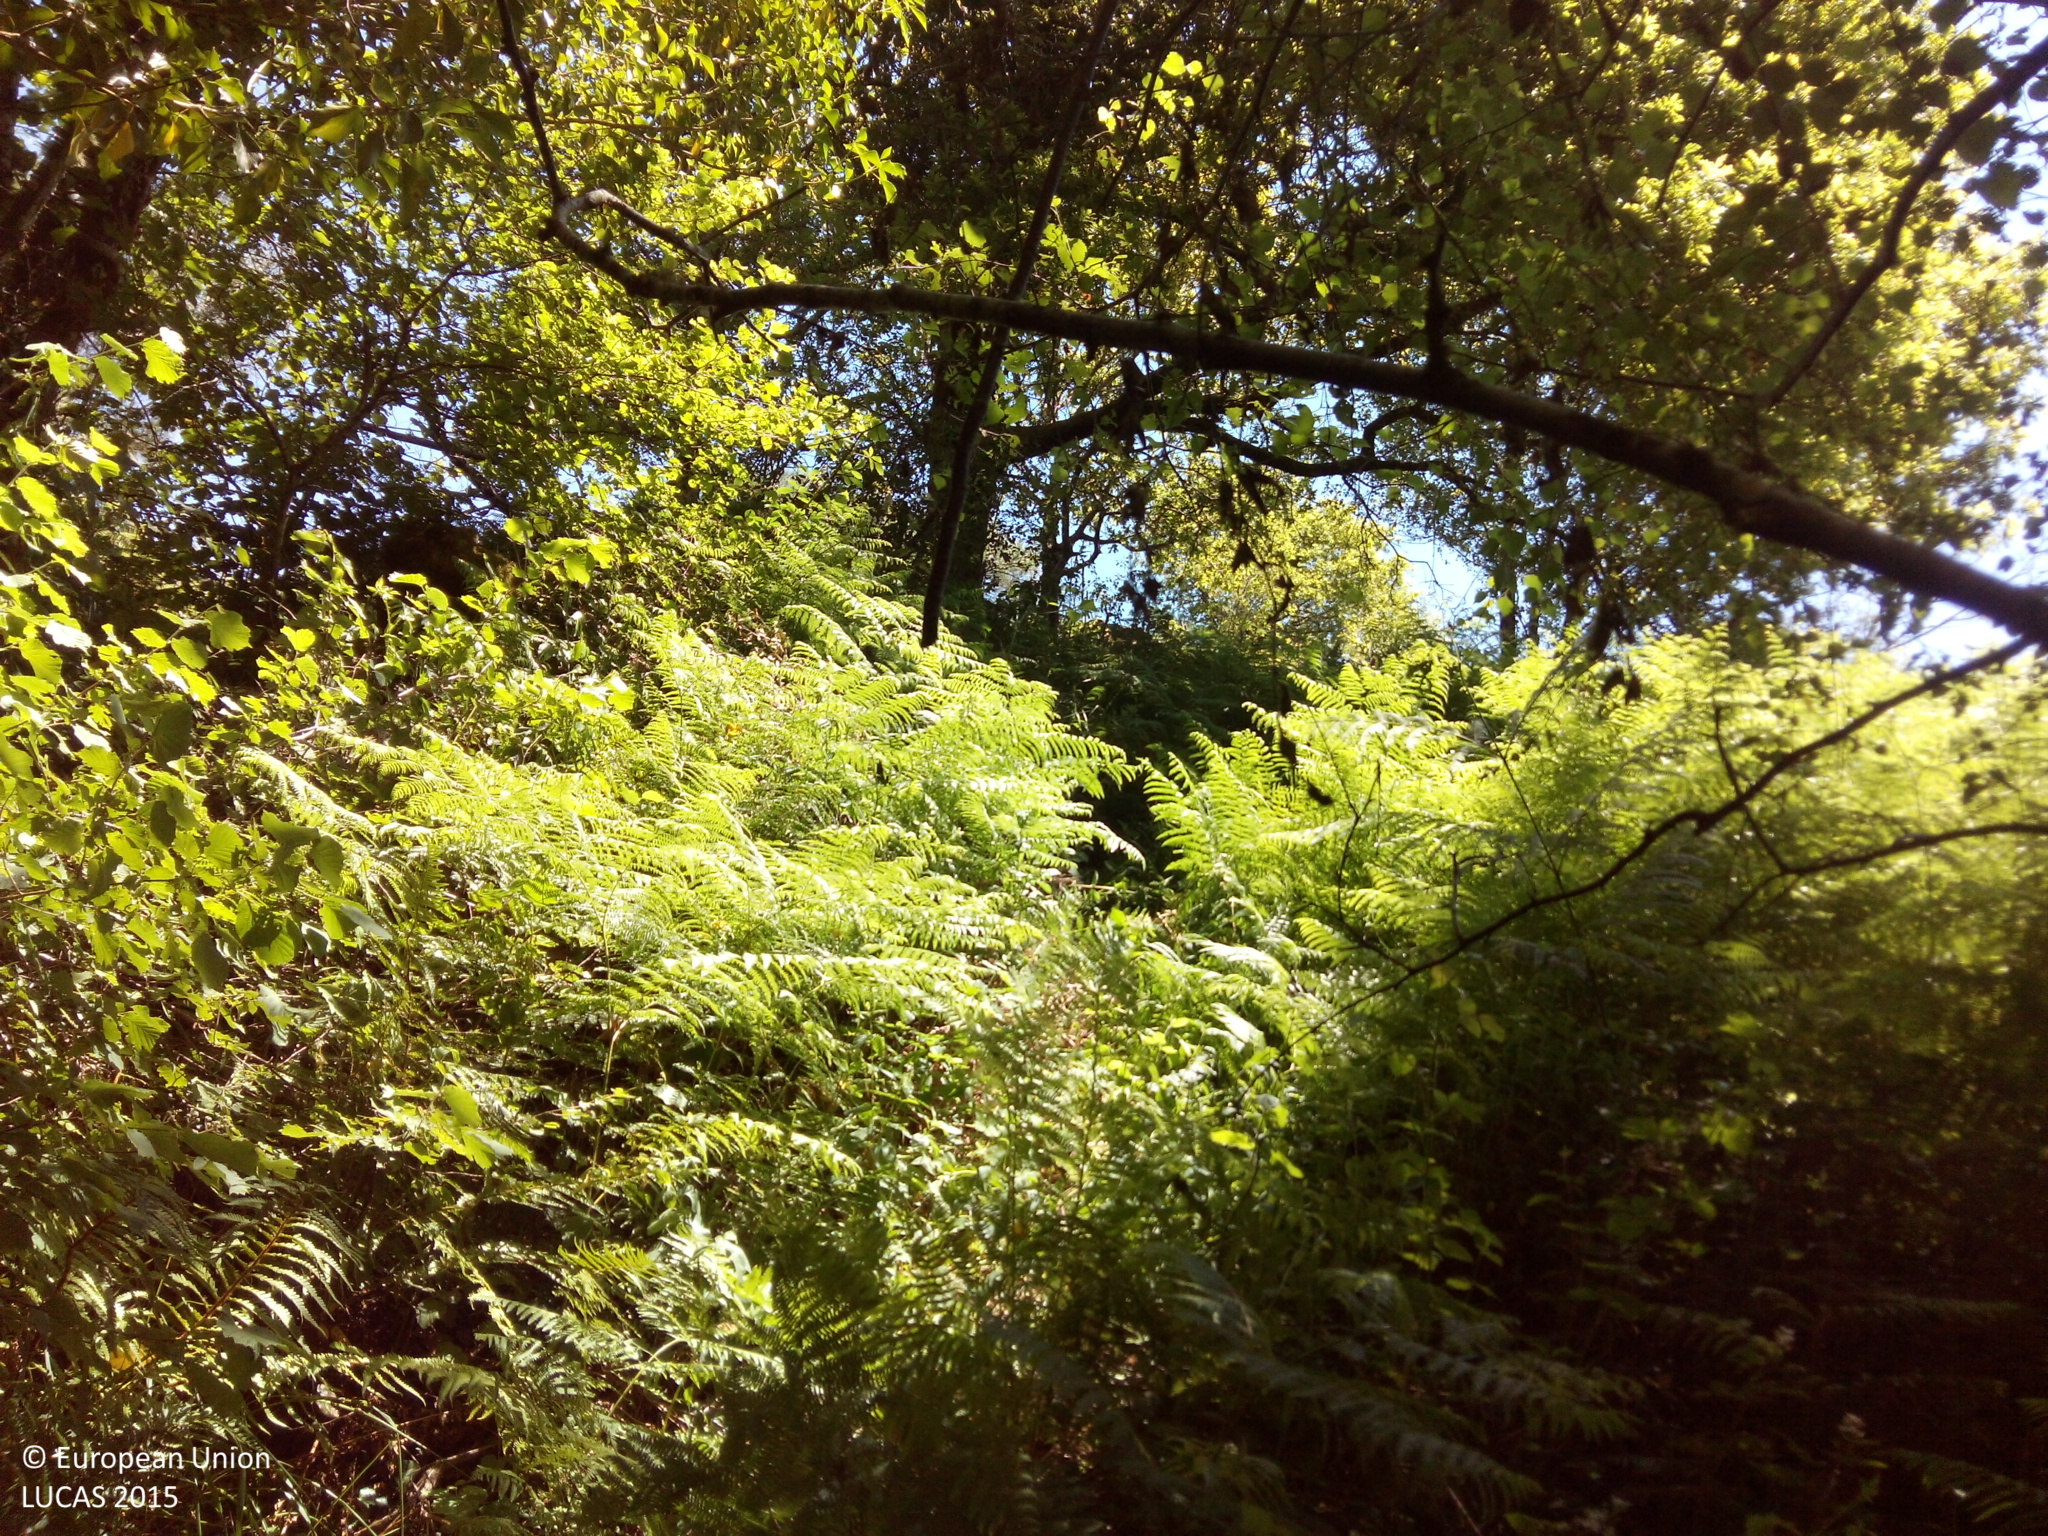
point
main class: Woodland
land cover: Broadleaved woodland
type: acidophilous oak and oak-birch forest
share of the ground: > 75 %
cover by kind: broadleaved forest trees 100 %
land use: Forestry
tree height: > 5 m
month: June
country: ES
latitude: 42.4618
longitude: -8.4221
